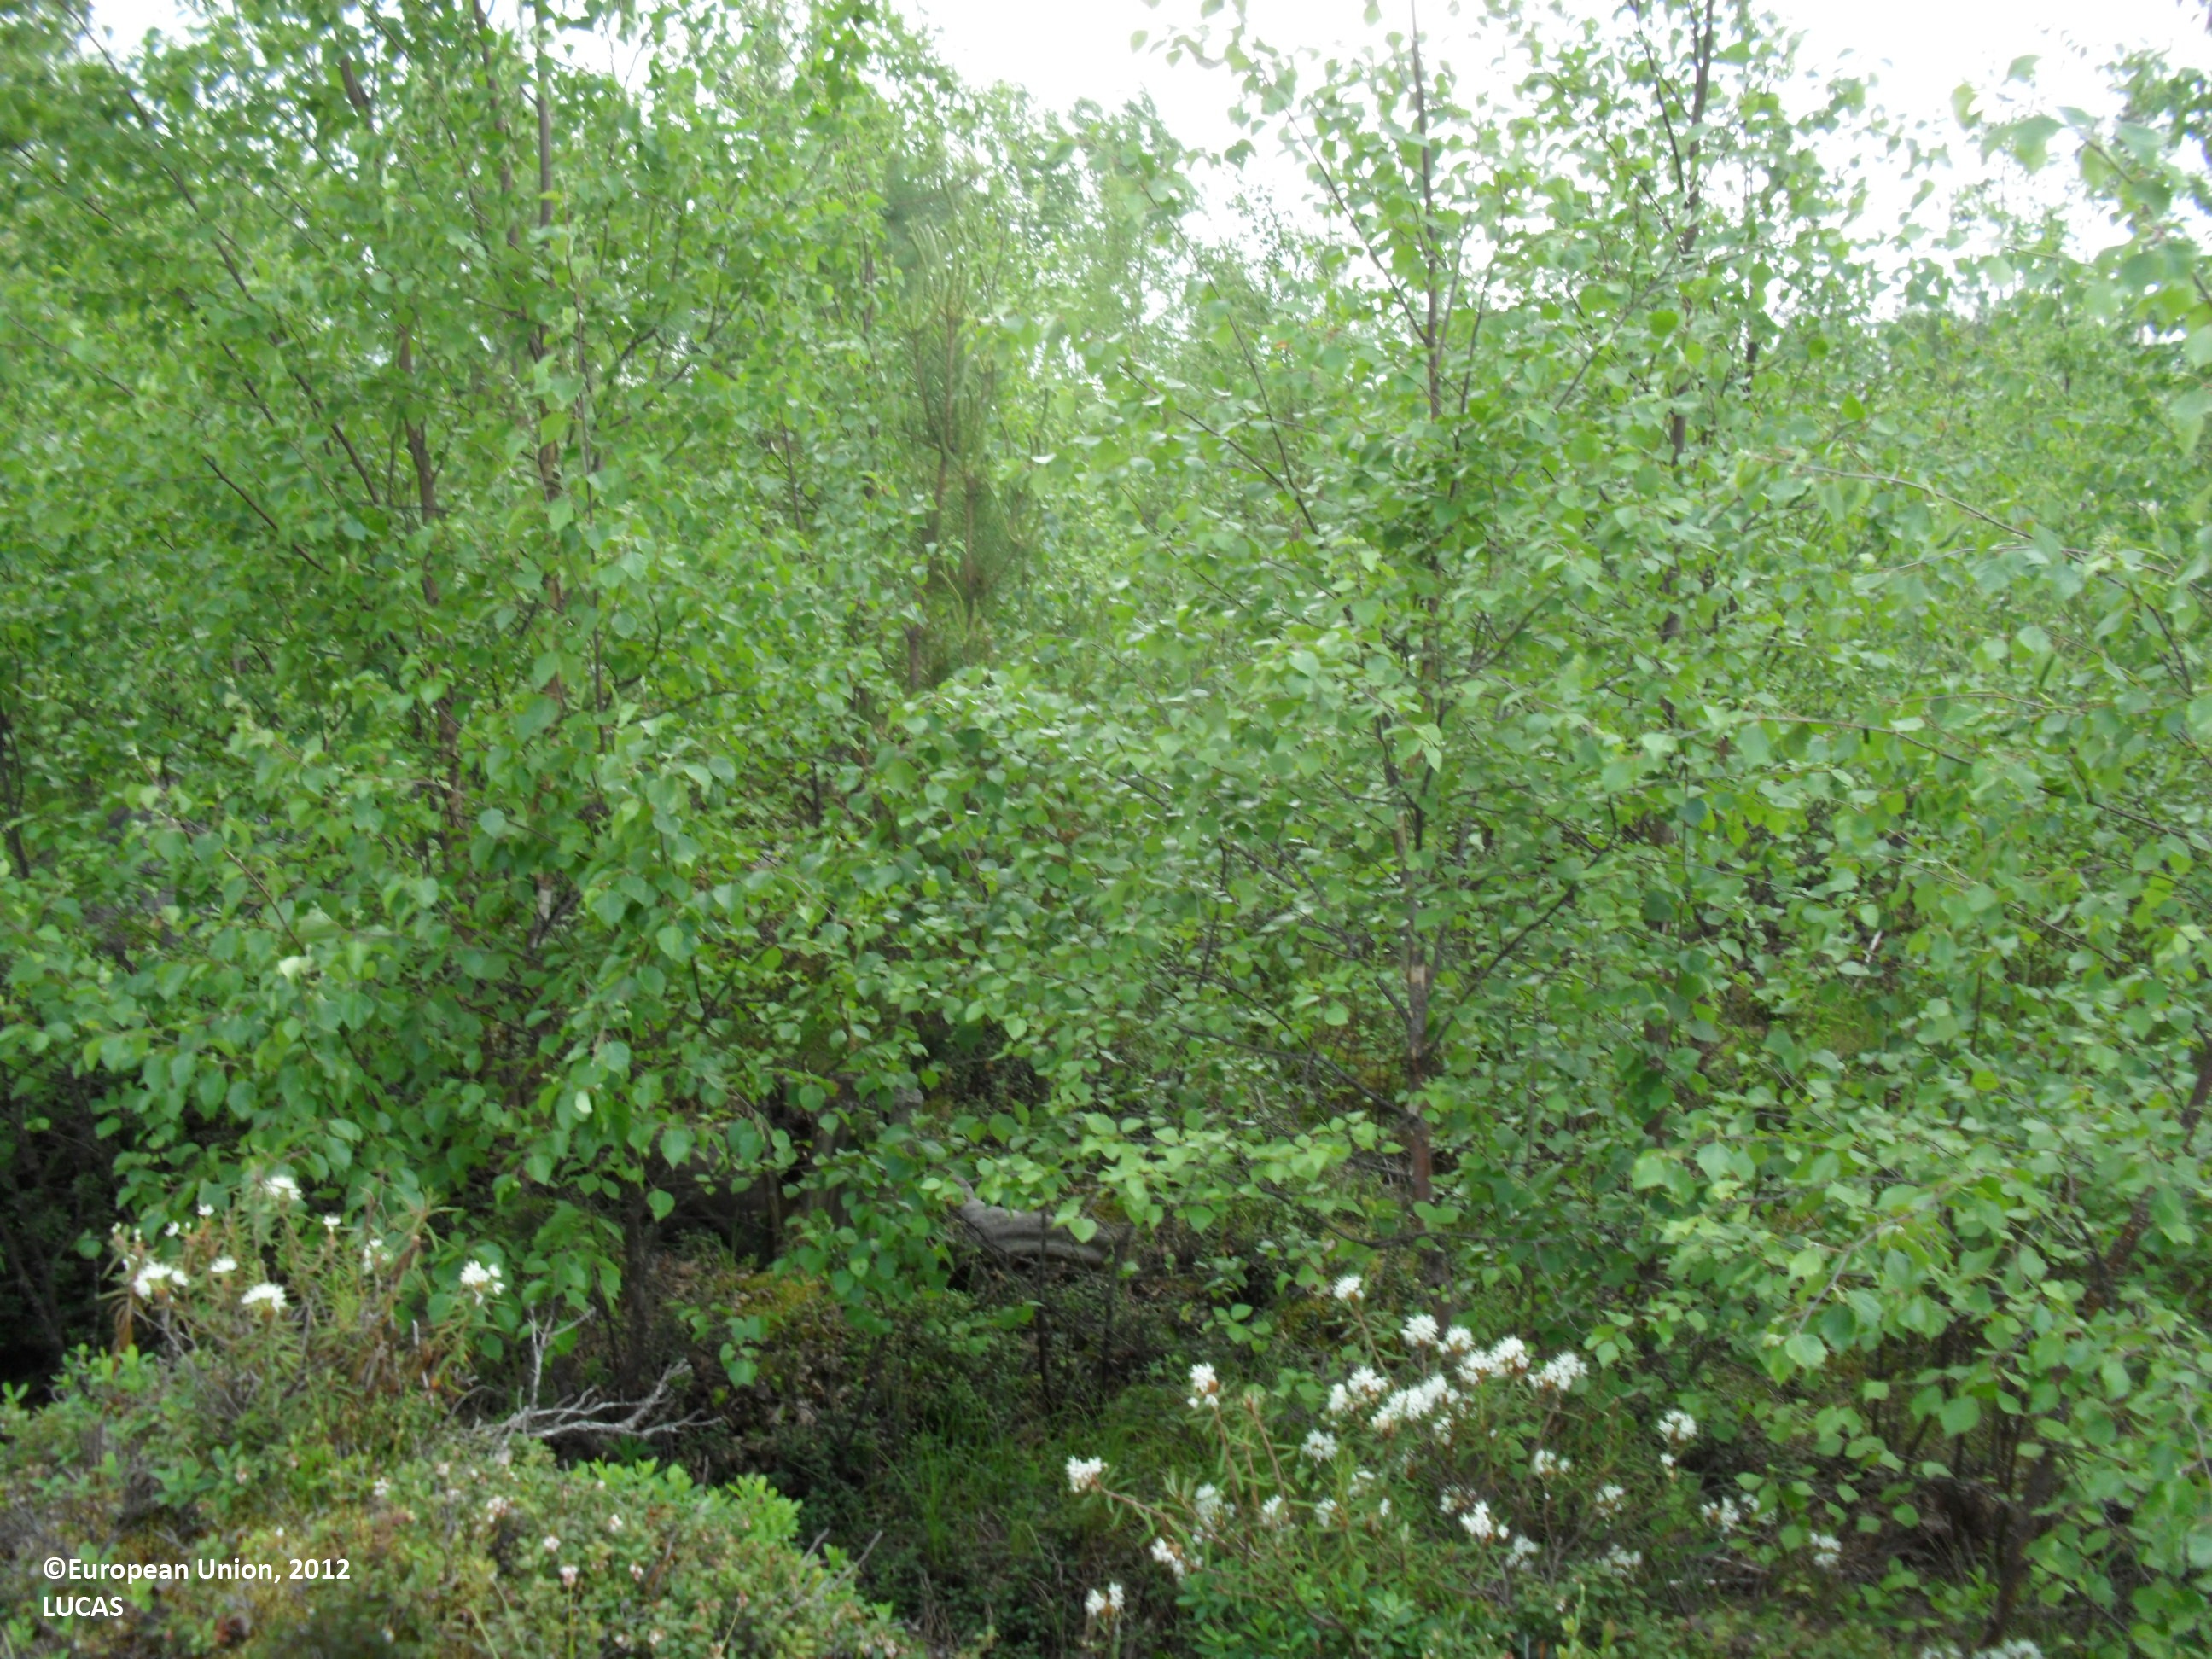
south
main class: Woodland
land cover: Other mixed woodland
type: boreal forest
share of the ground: 10 - 25 %
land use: Forestry
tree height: < 5 m
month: June
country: FI
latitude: 63.2225
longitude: 23.1702
